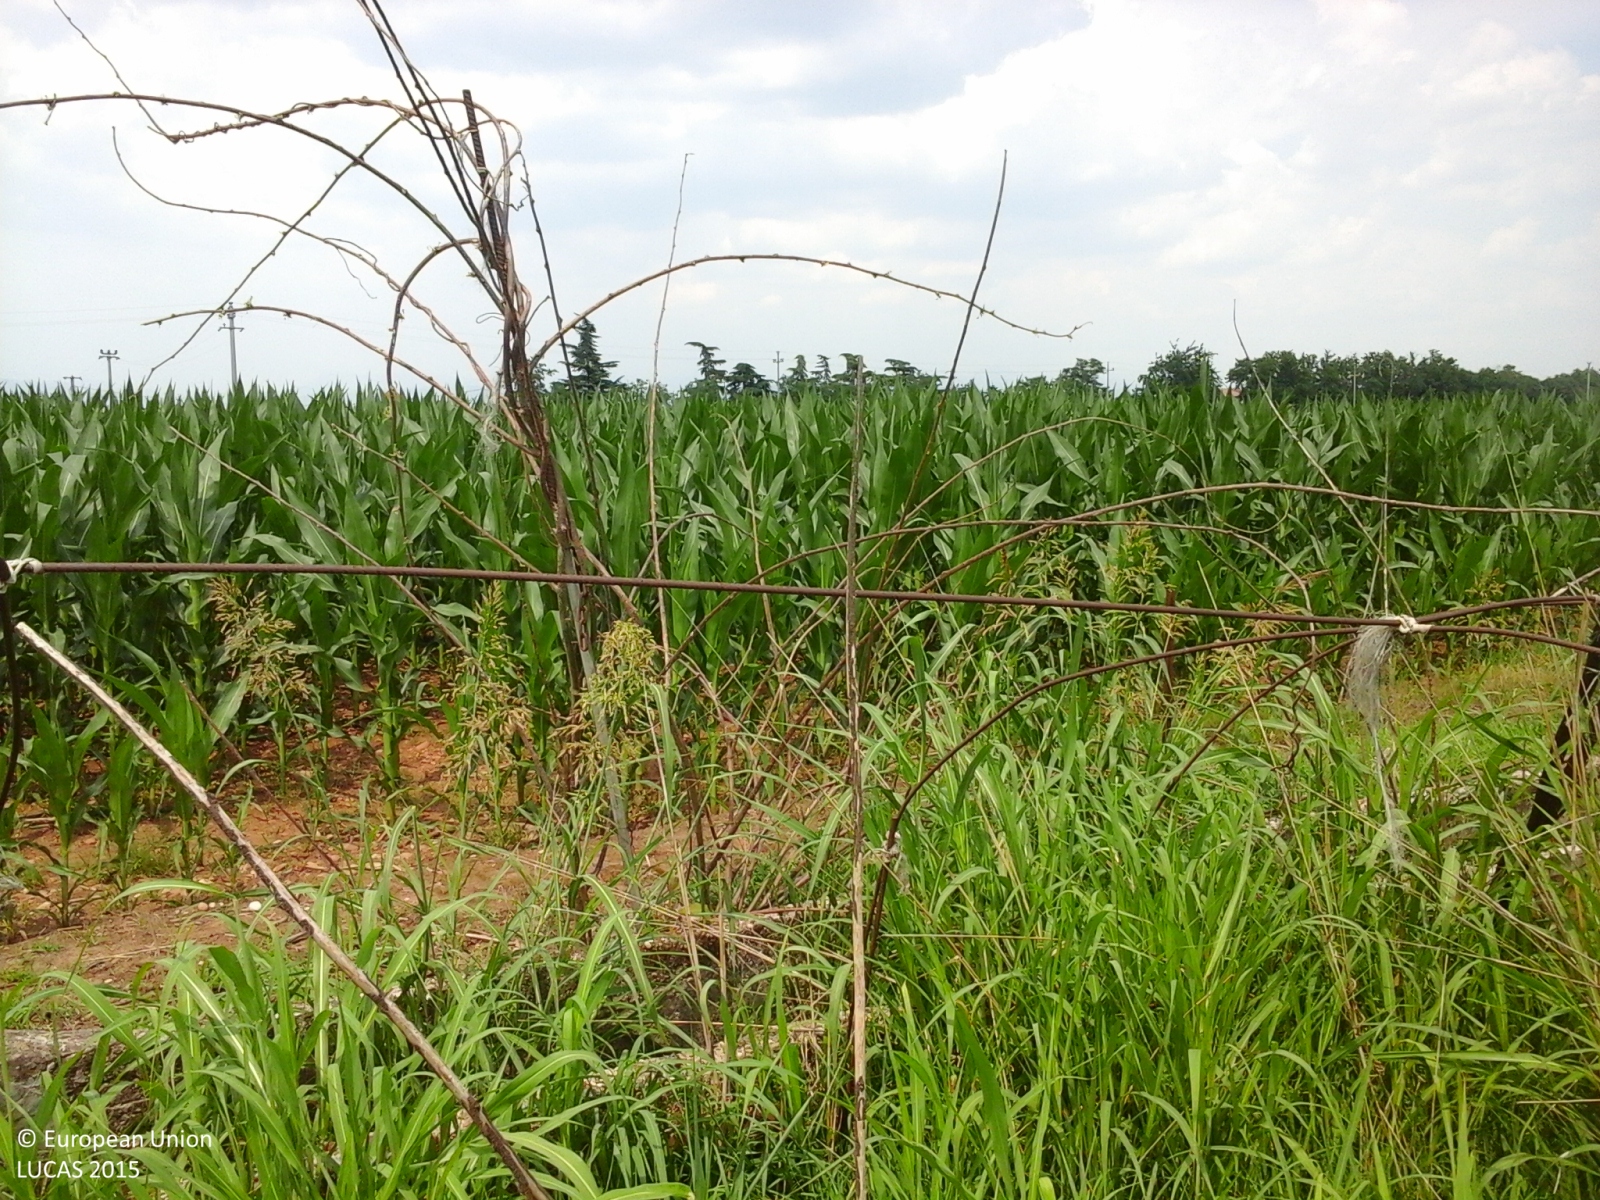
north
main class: Cropland
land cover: Maize
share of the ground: > 75 %
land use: Agriculture (excluding fallow land and kitchen gardens)
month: June
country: IT
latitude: 45.4106
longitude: 10.8801
